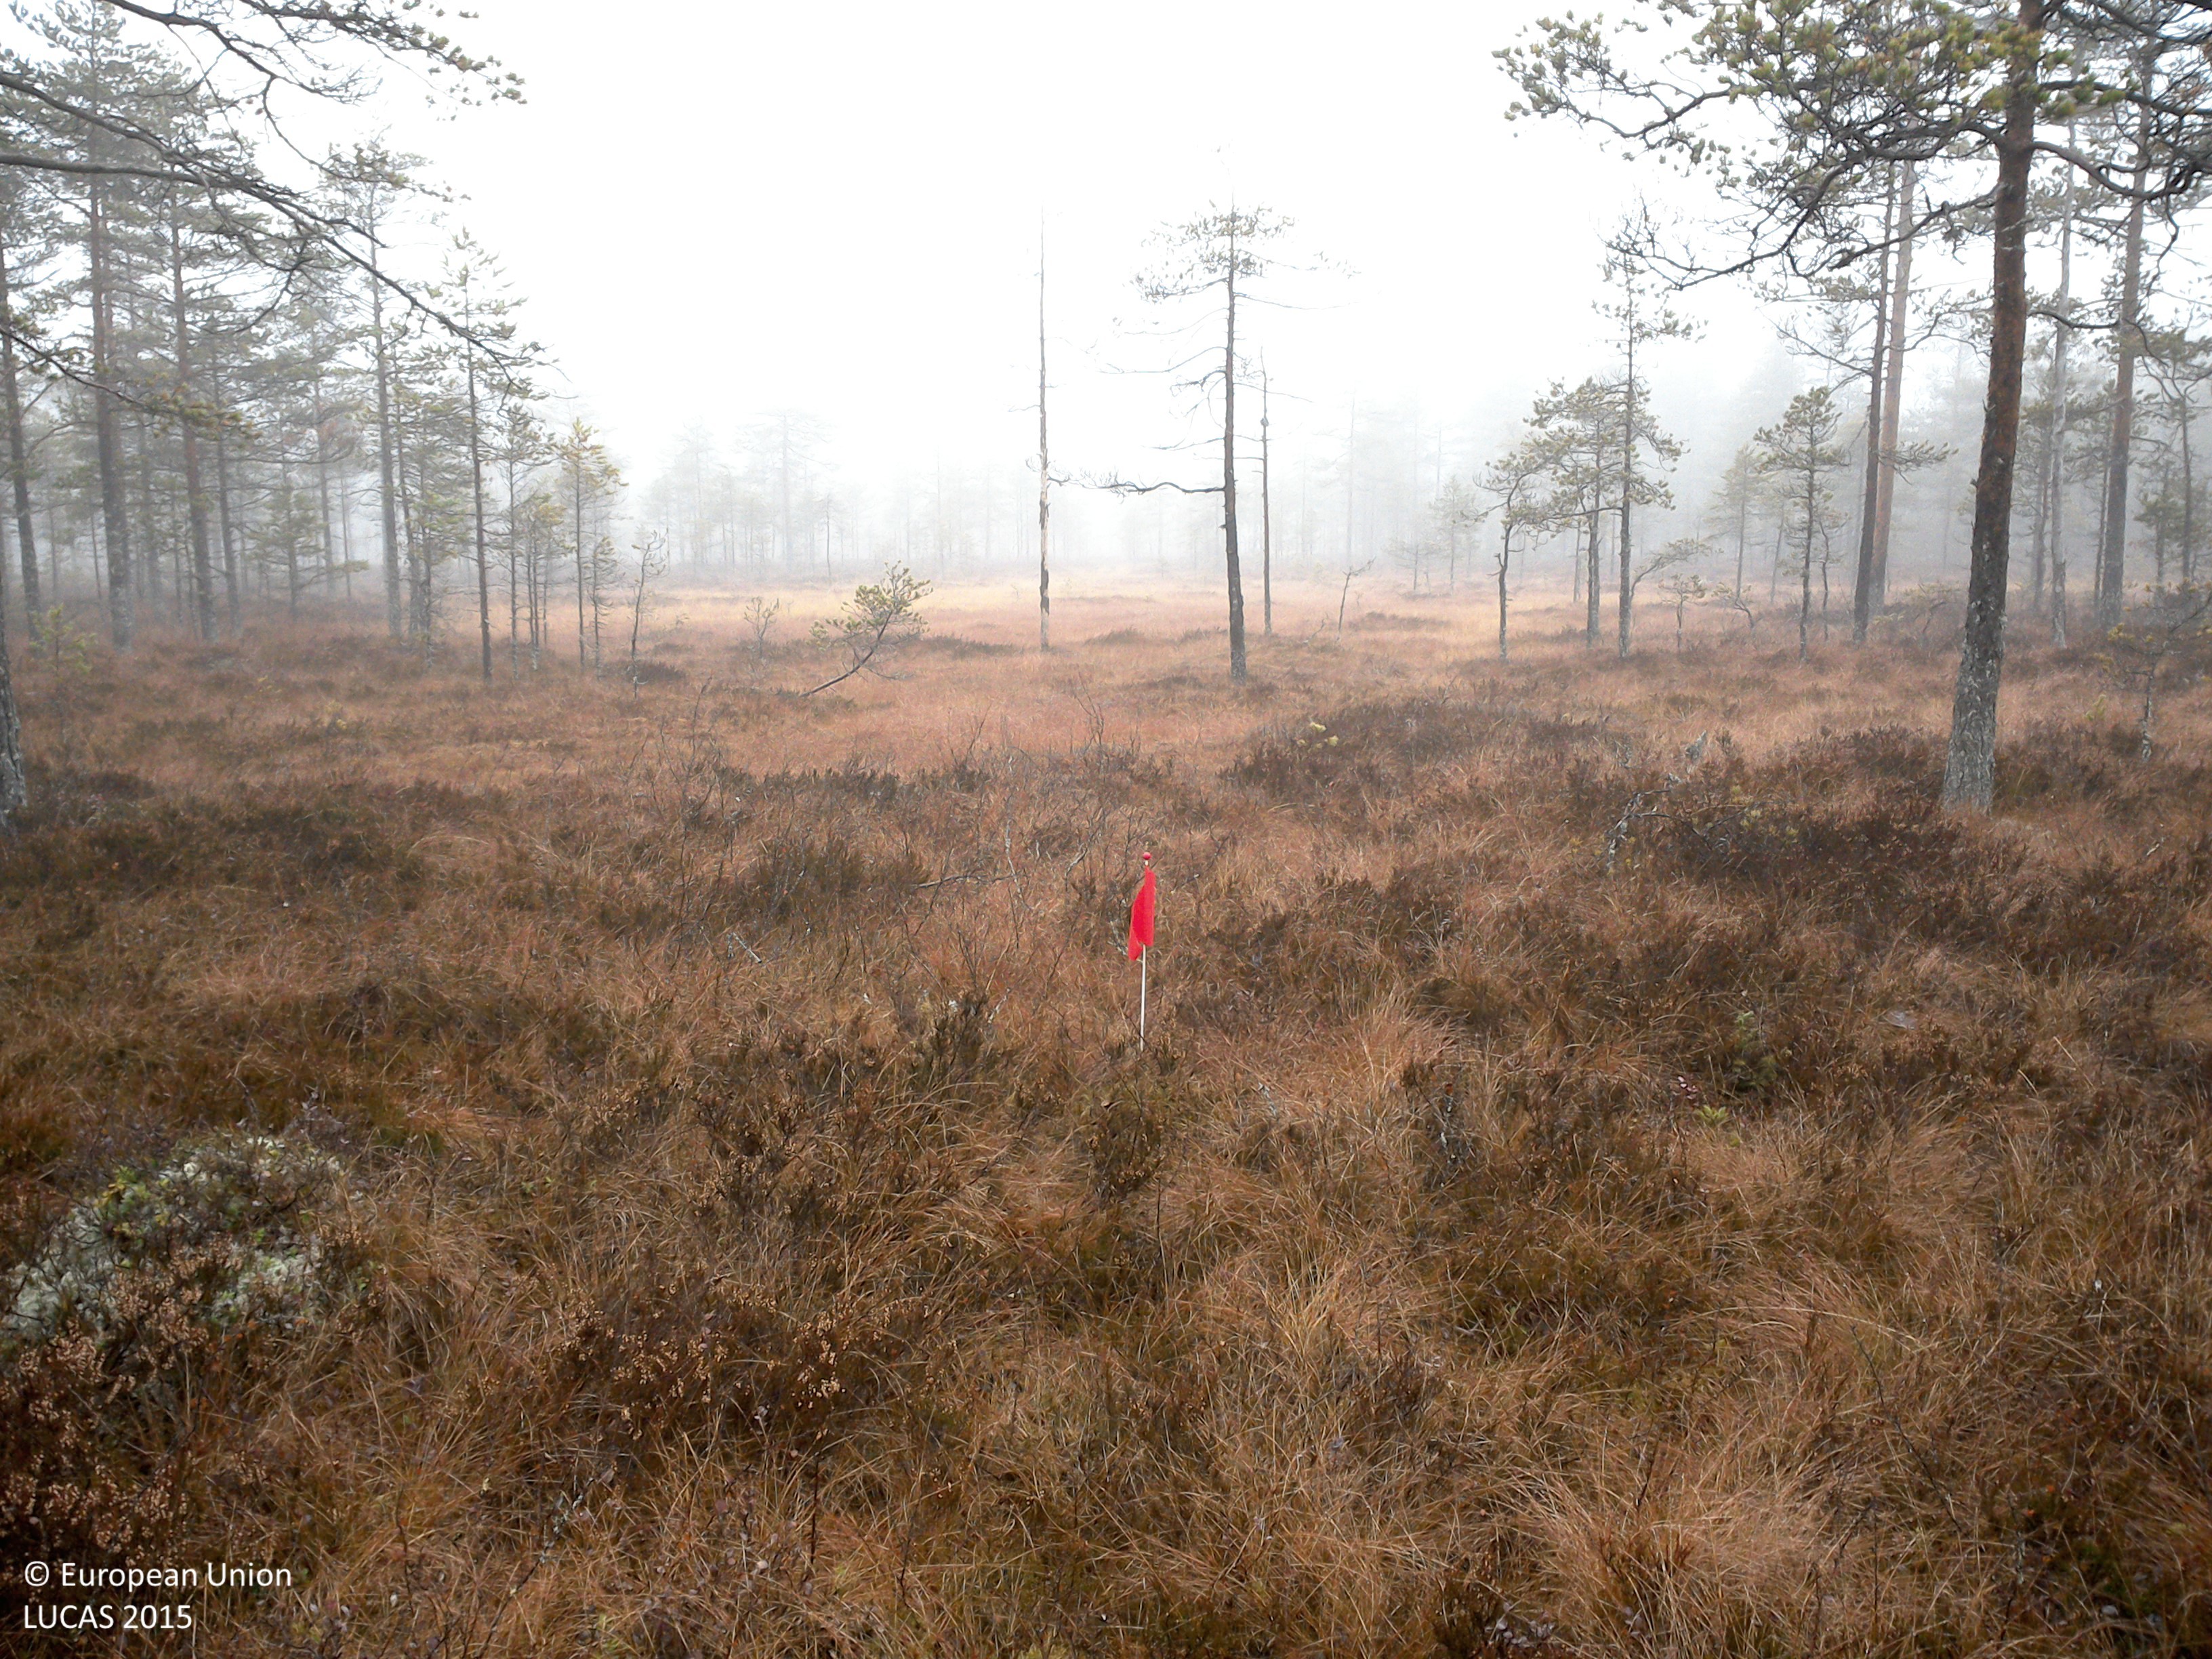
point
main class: Woodland
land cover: Pine dominated coniferous woodland
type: boreal forest
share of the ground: 25 - 50 %
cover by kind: coniferous forest trees 40 %, shrubs 30 %, herbaceous plants 15 %, lichens and mosses 15 %
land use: Forestry
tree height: > 5 m
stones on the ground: < 10 %
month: November
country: SE
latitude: 60.5901
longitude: 14.6796
